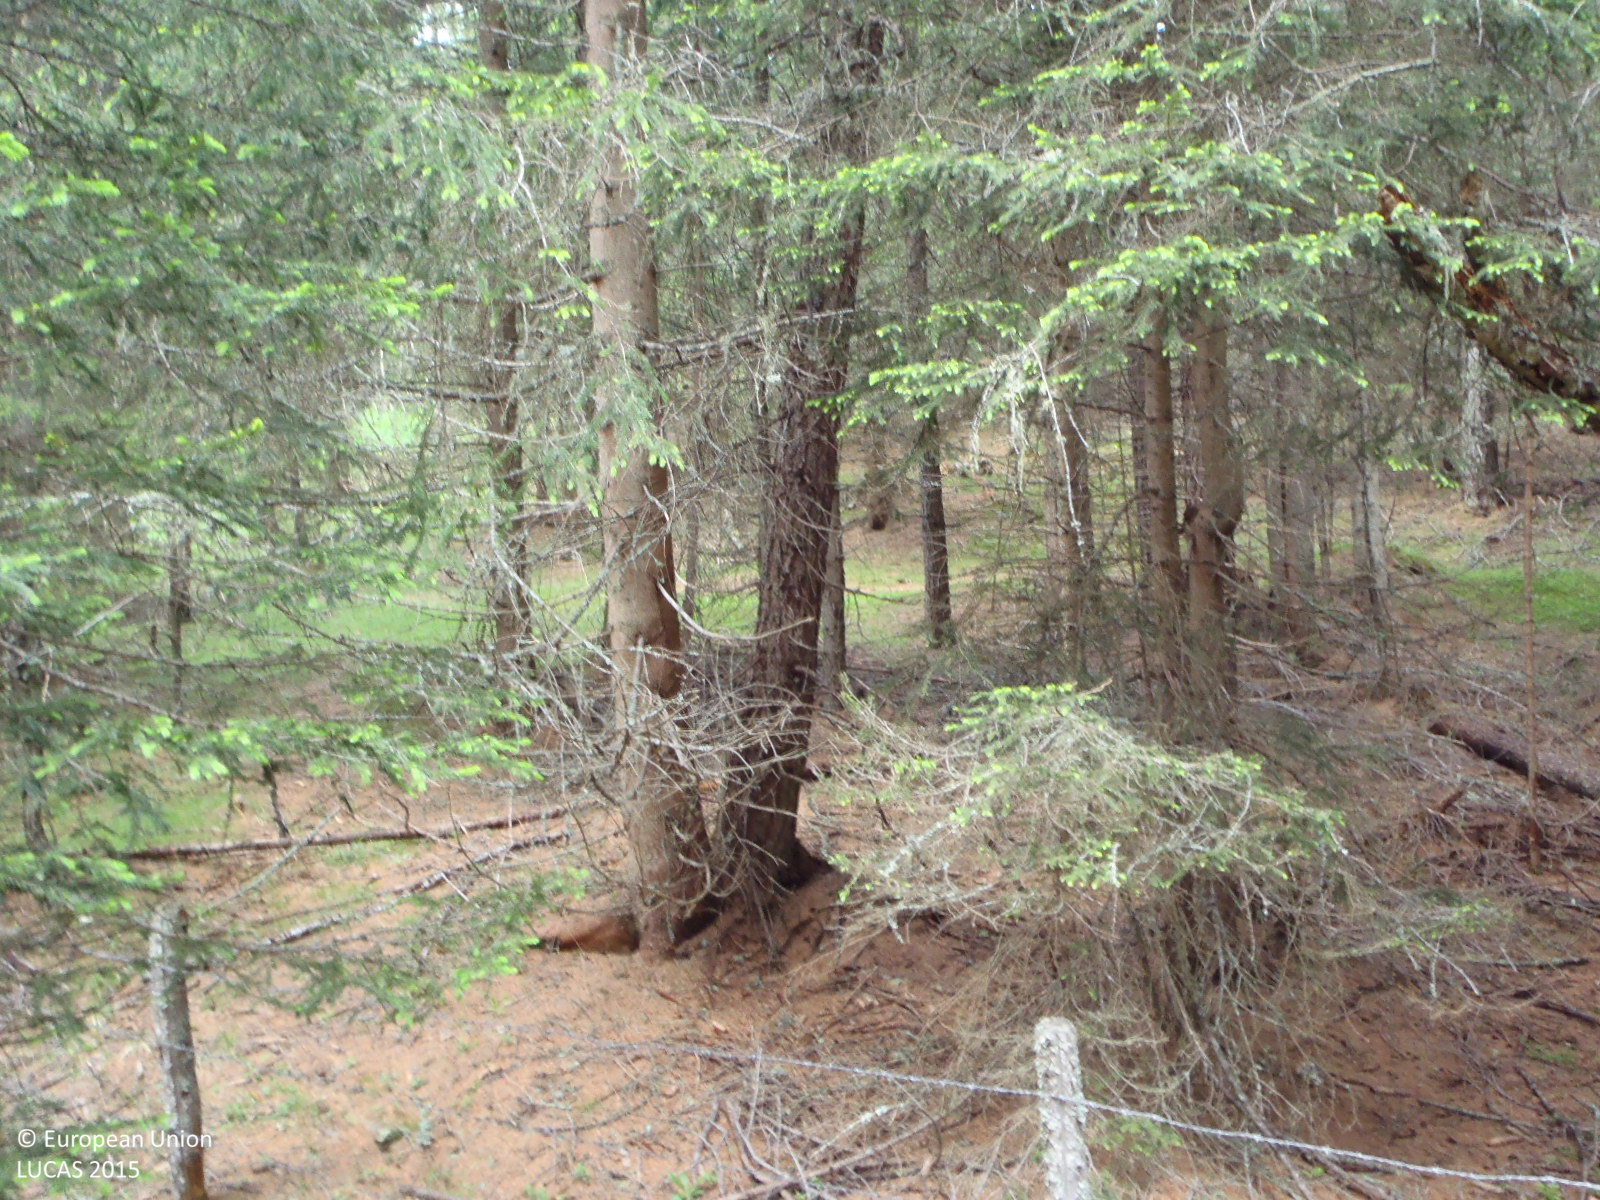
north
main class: Woodland
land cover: Other coniferous woodland
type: alpine coniferous forest
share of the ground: > 75 %
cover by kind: coniferous forest trees 100 %
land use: Forestry
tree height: > 5 m
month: June
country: AT
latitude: 47.1071
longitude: 13.9645
